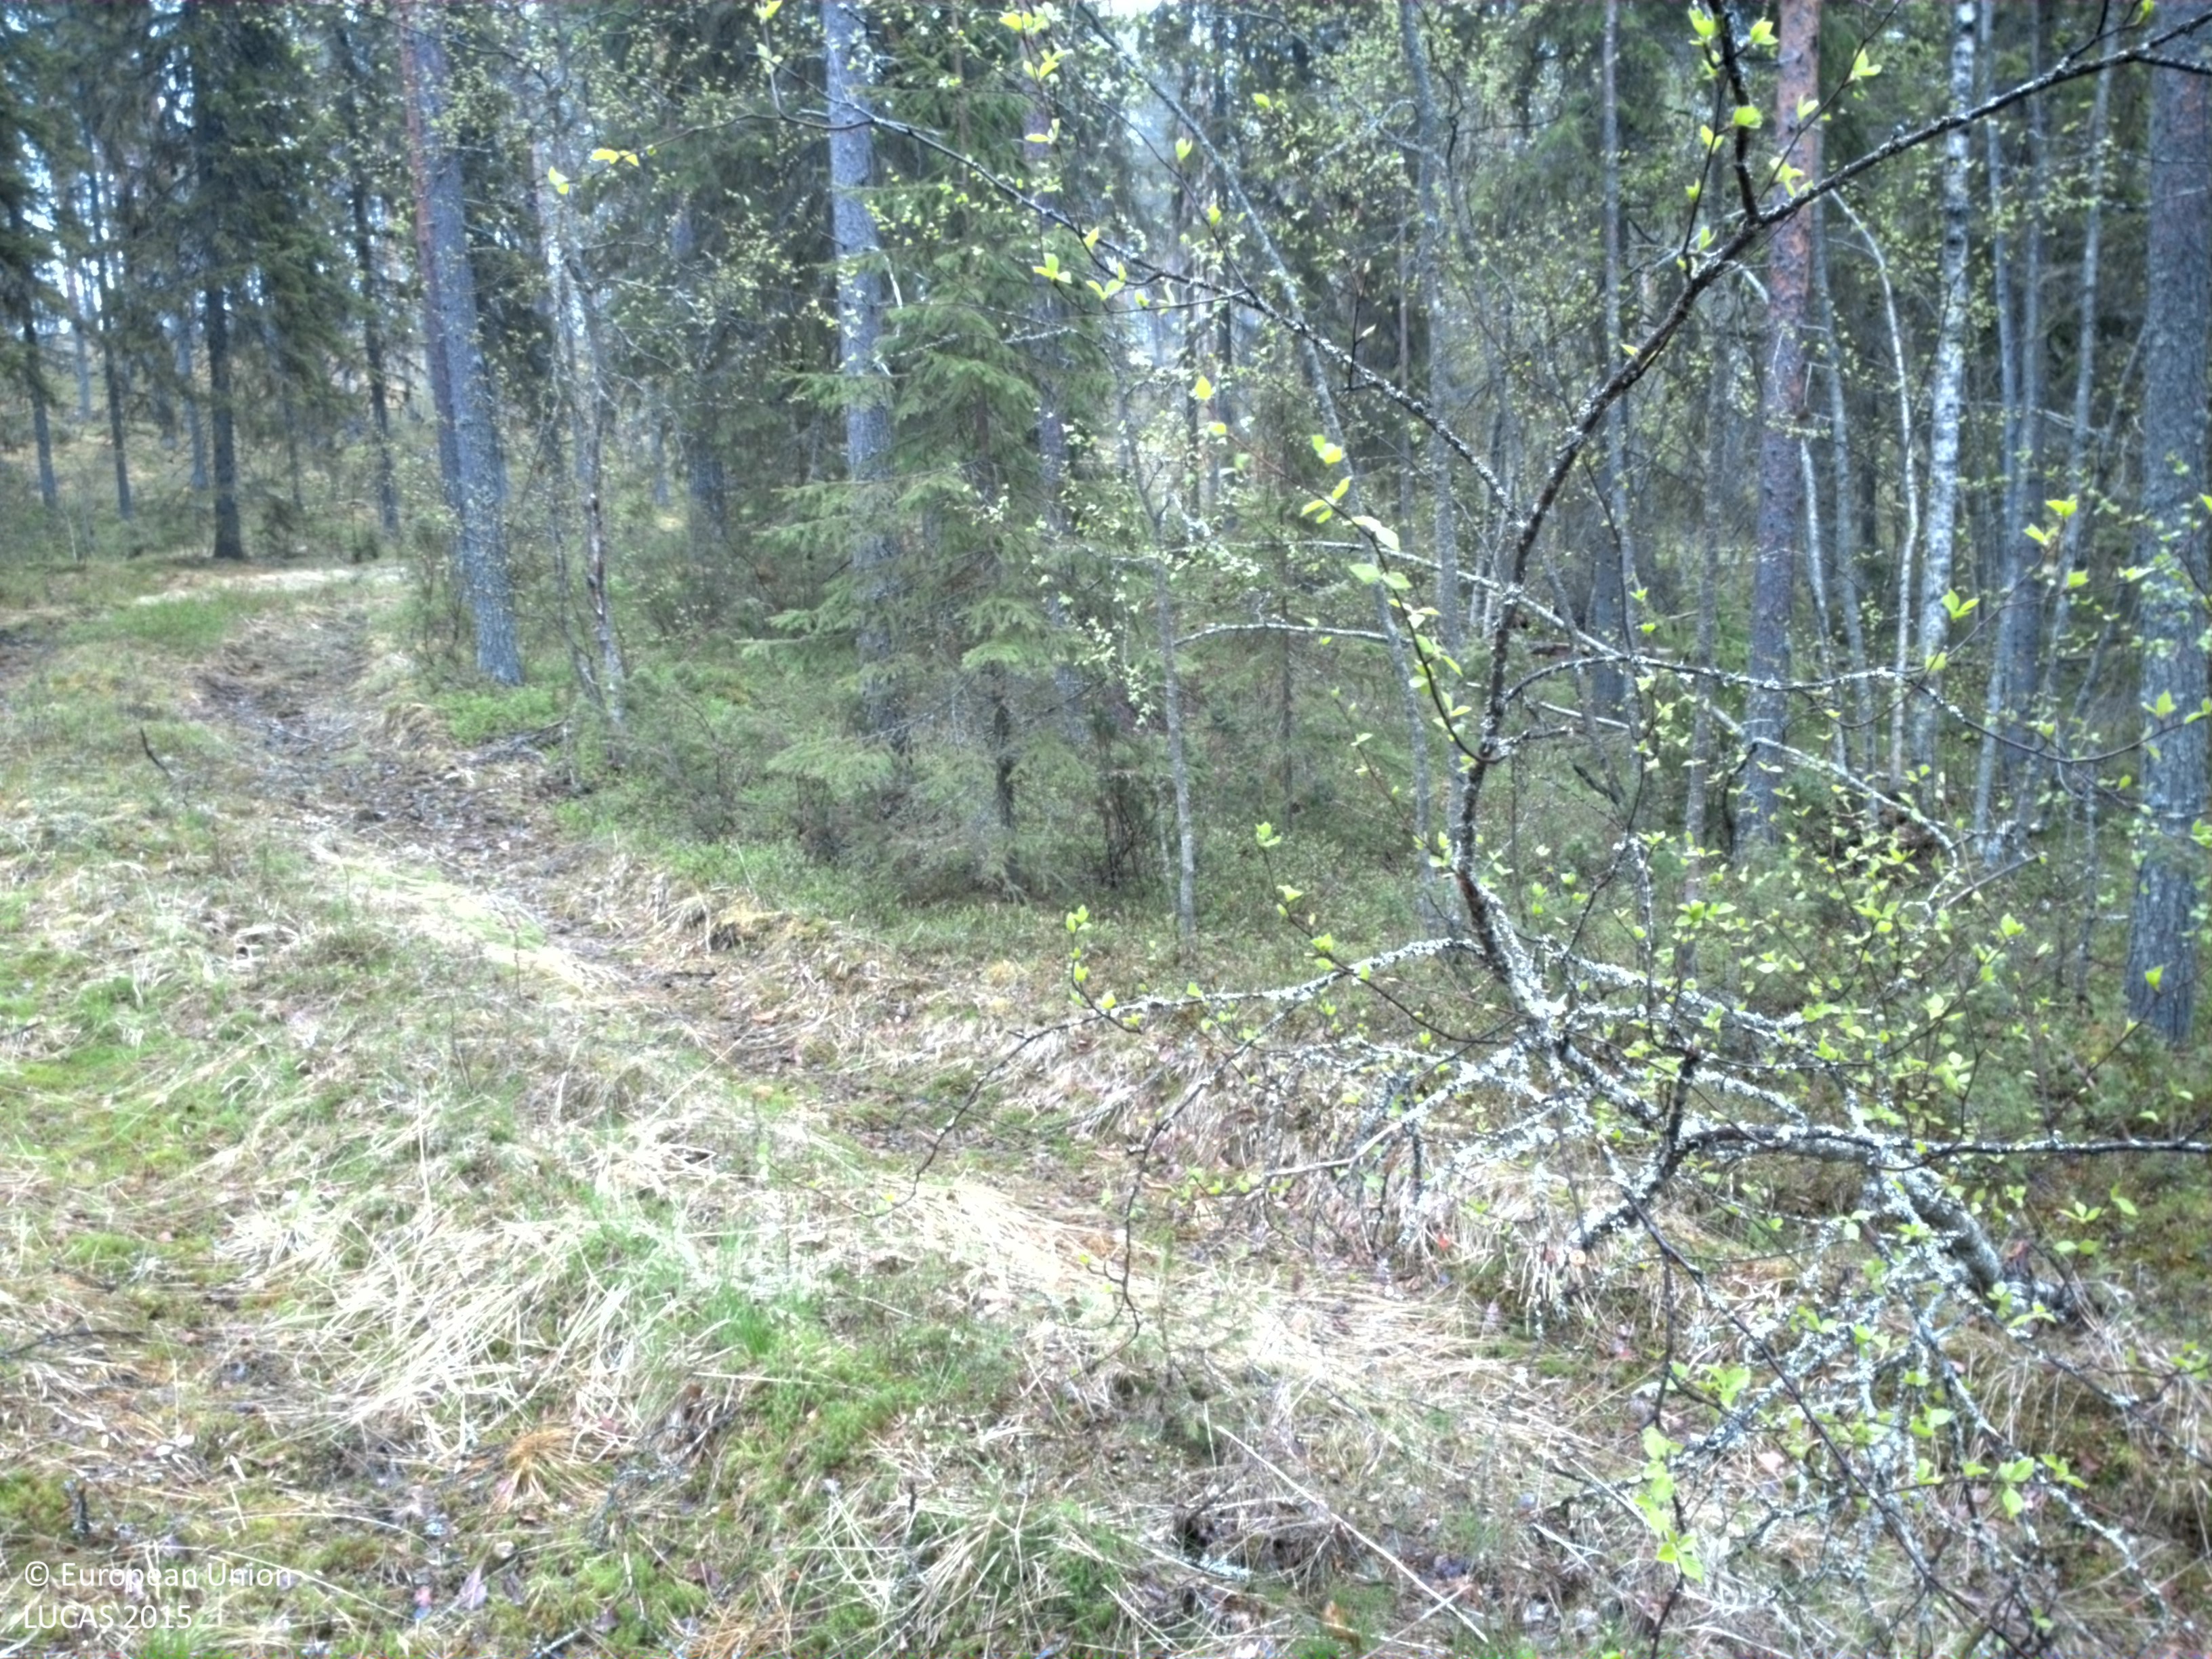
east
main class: Woodland
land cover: Pine dominated coniferous woodland
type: boreal forest
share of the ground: 50 - 75 %
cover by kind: coniferous forest trees 65 %, shrubs 30 %, broadleaved forest trees 5 %
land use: Forestry
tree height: > 5 m
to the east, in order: Pine dominated coniferous woodland; Ditches and canals; Pine dominated coniferous woodland; Ditches and canals; Pine dominated coniferous woodland; Ditches and canals; Pine dominated coniferous woodland; Tracks
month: June
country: SE
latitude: 66.0205
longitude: 23.1056
